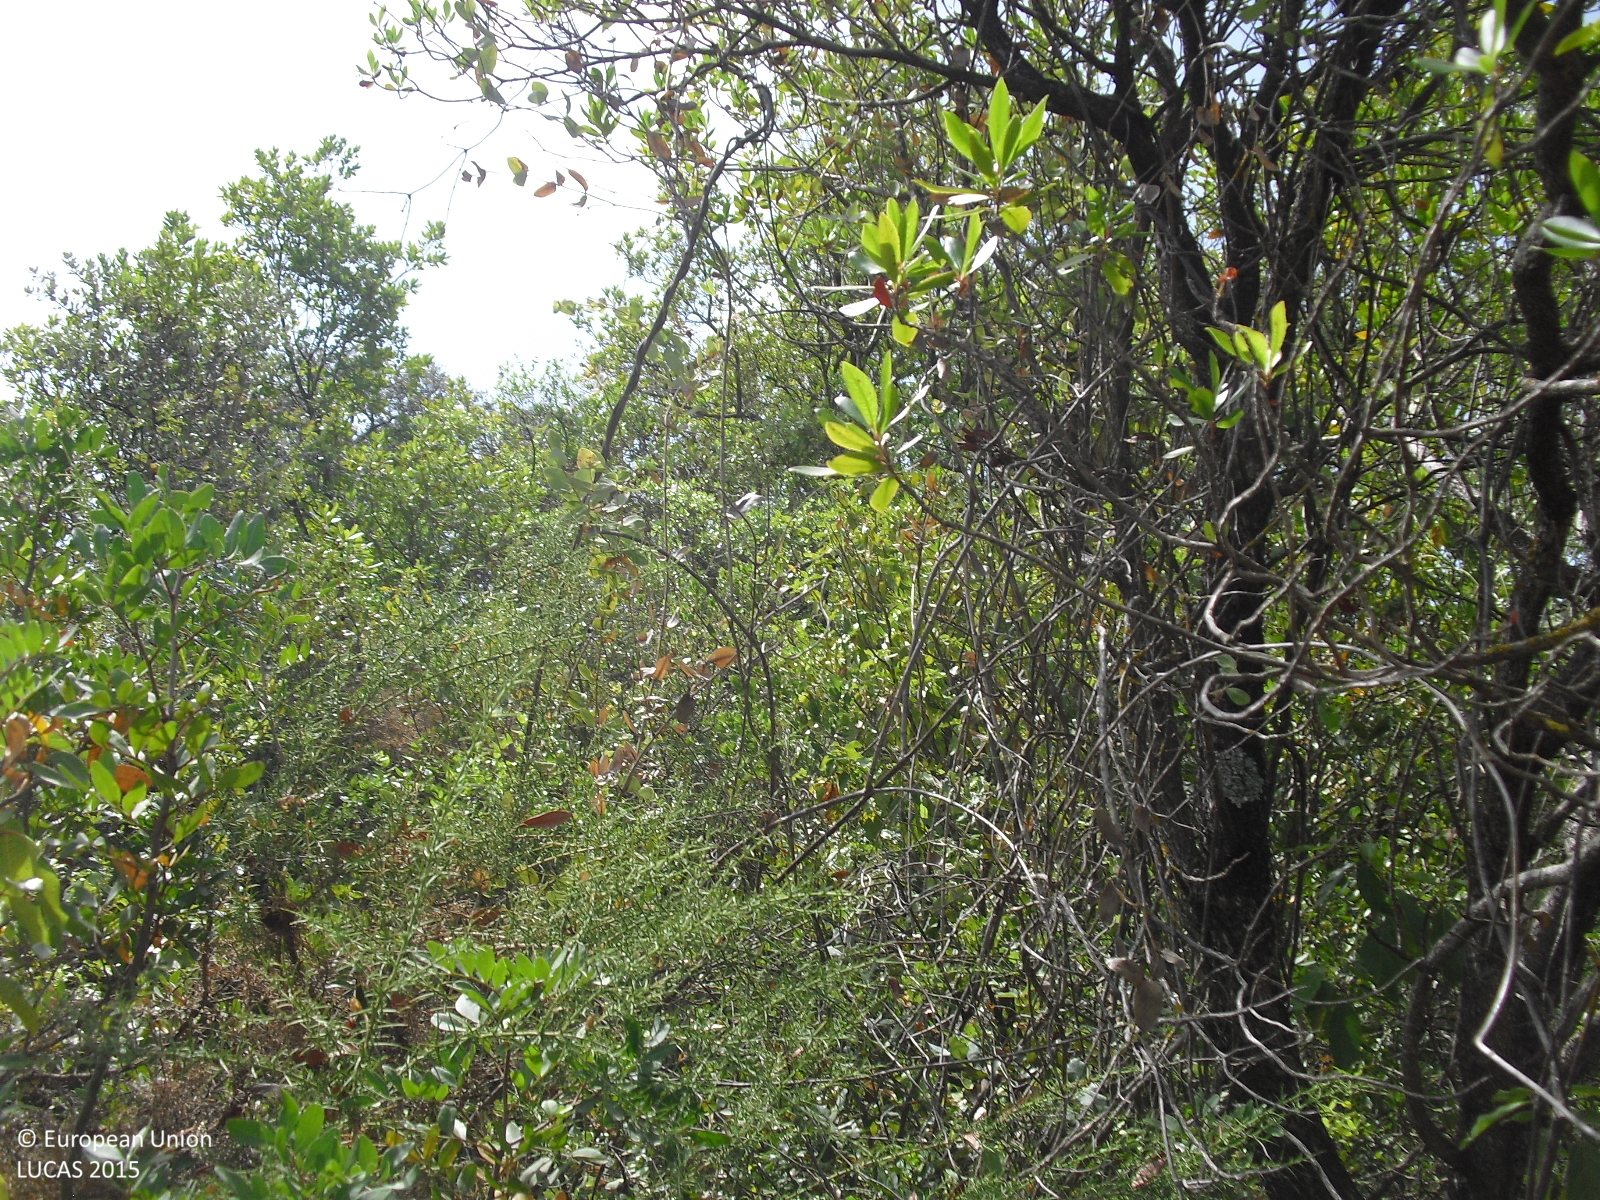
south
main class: Woodland
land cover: Broadleaved woodland
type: broadleaved evergreen forest
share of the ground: 25 - 50 %
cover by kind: shrubs 65 %, broadleaved forest trees 35 %
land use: Semi-natural and natural areas not in use
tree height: < 5 m
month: August
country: ES
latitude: 37.3697
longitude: -4.3524
